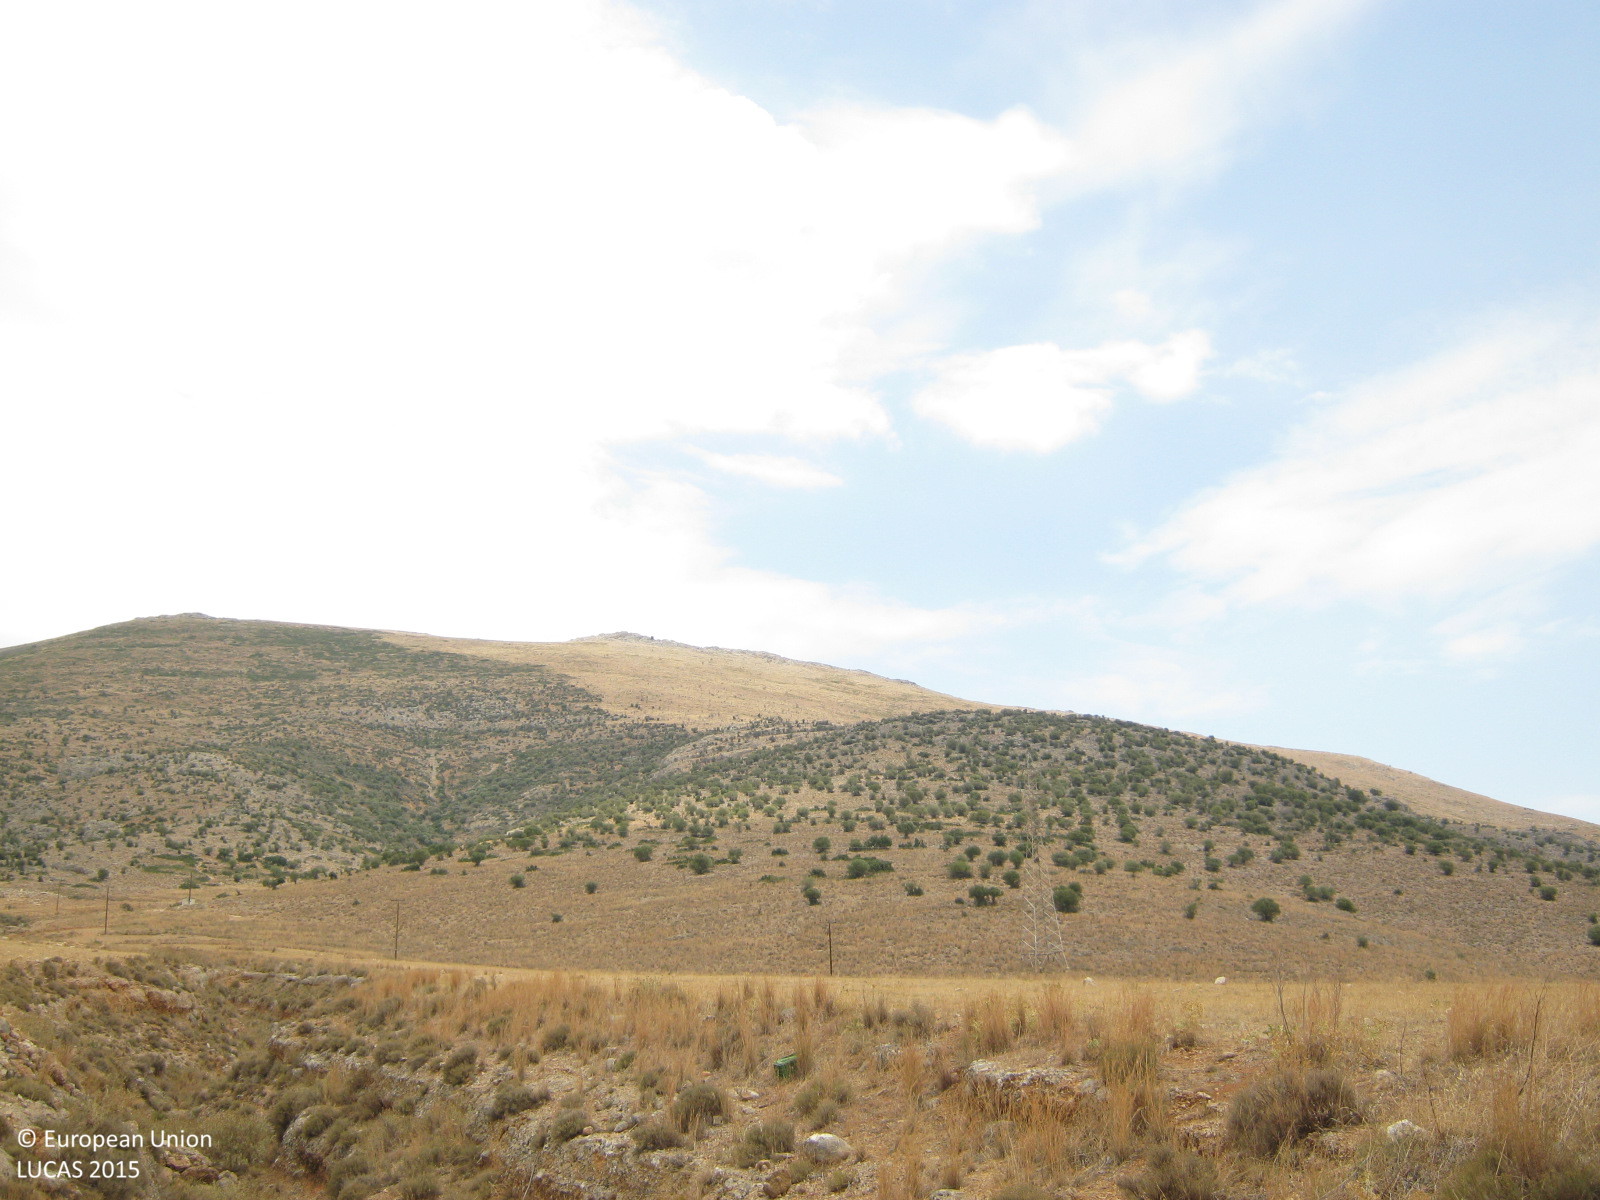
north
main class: Cropland
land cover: Oranges
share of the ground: > 75 %
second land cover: Spontaneously vegetated surfaces
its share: 50 - 75 %
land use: Agriculture (excluding fallow land and kitchen gardens)
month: August
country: GR
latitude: 37.6864
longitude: 22.7927
